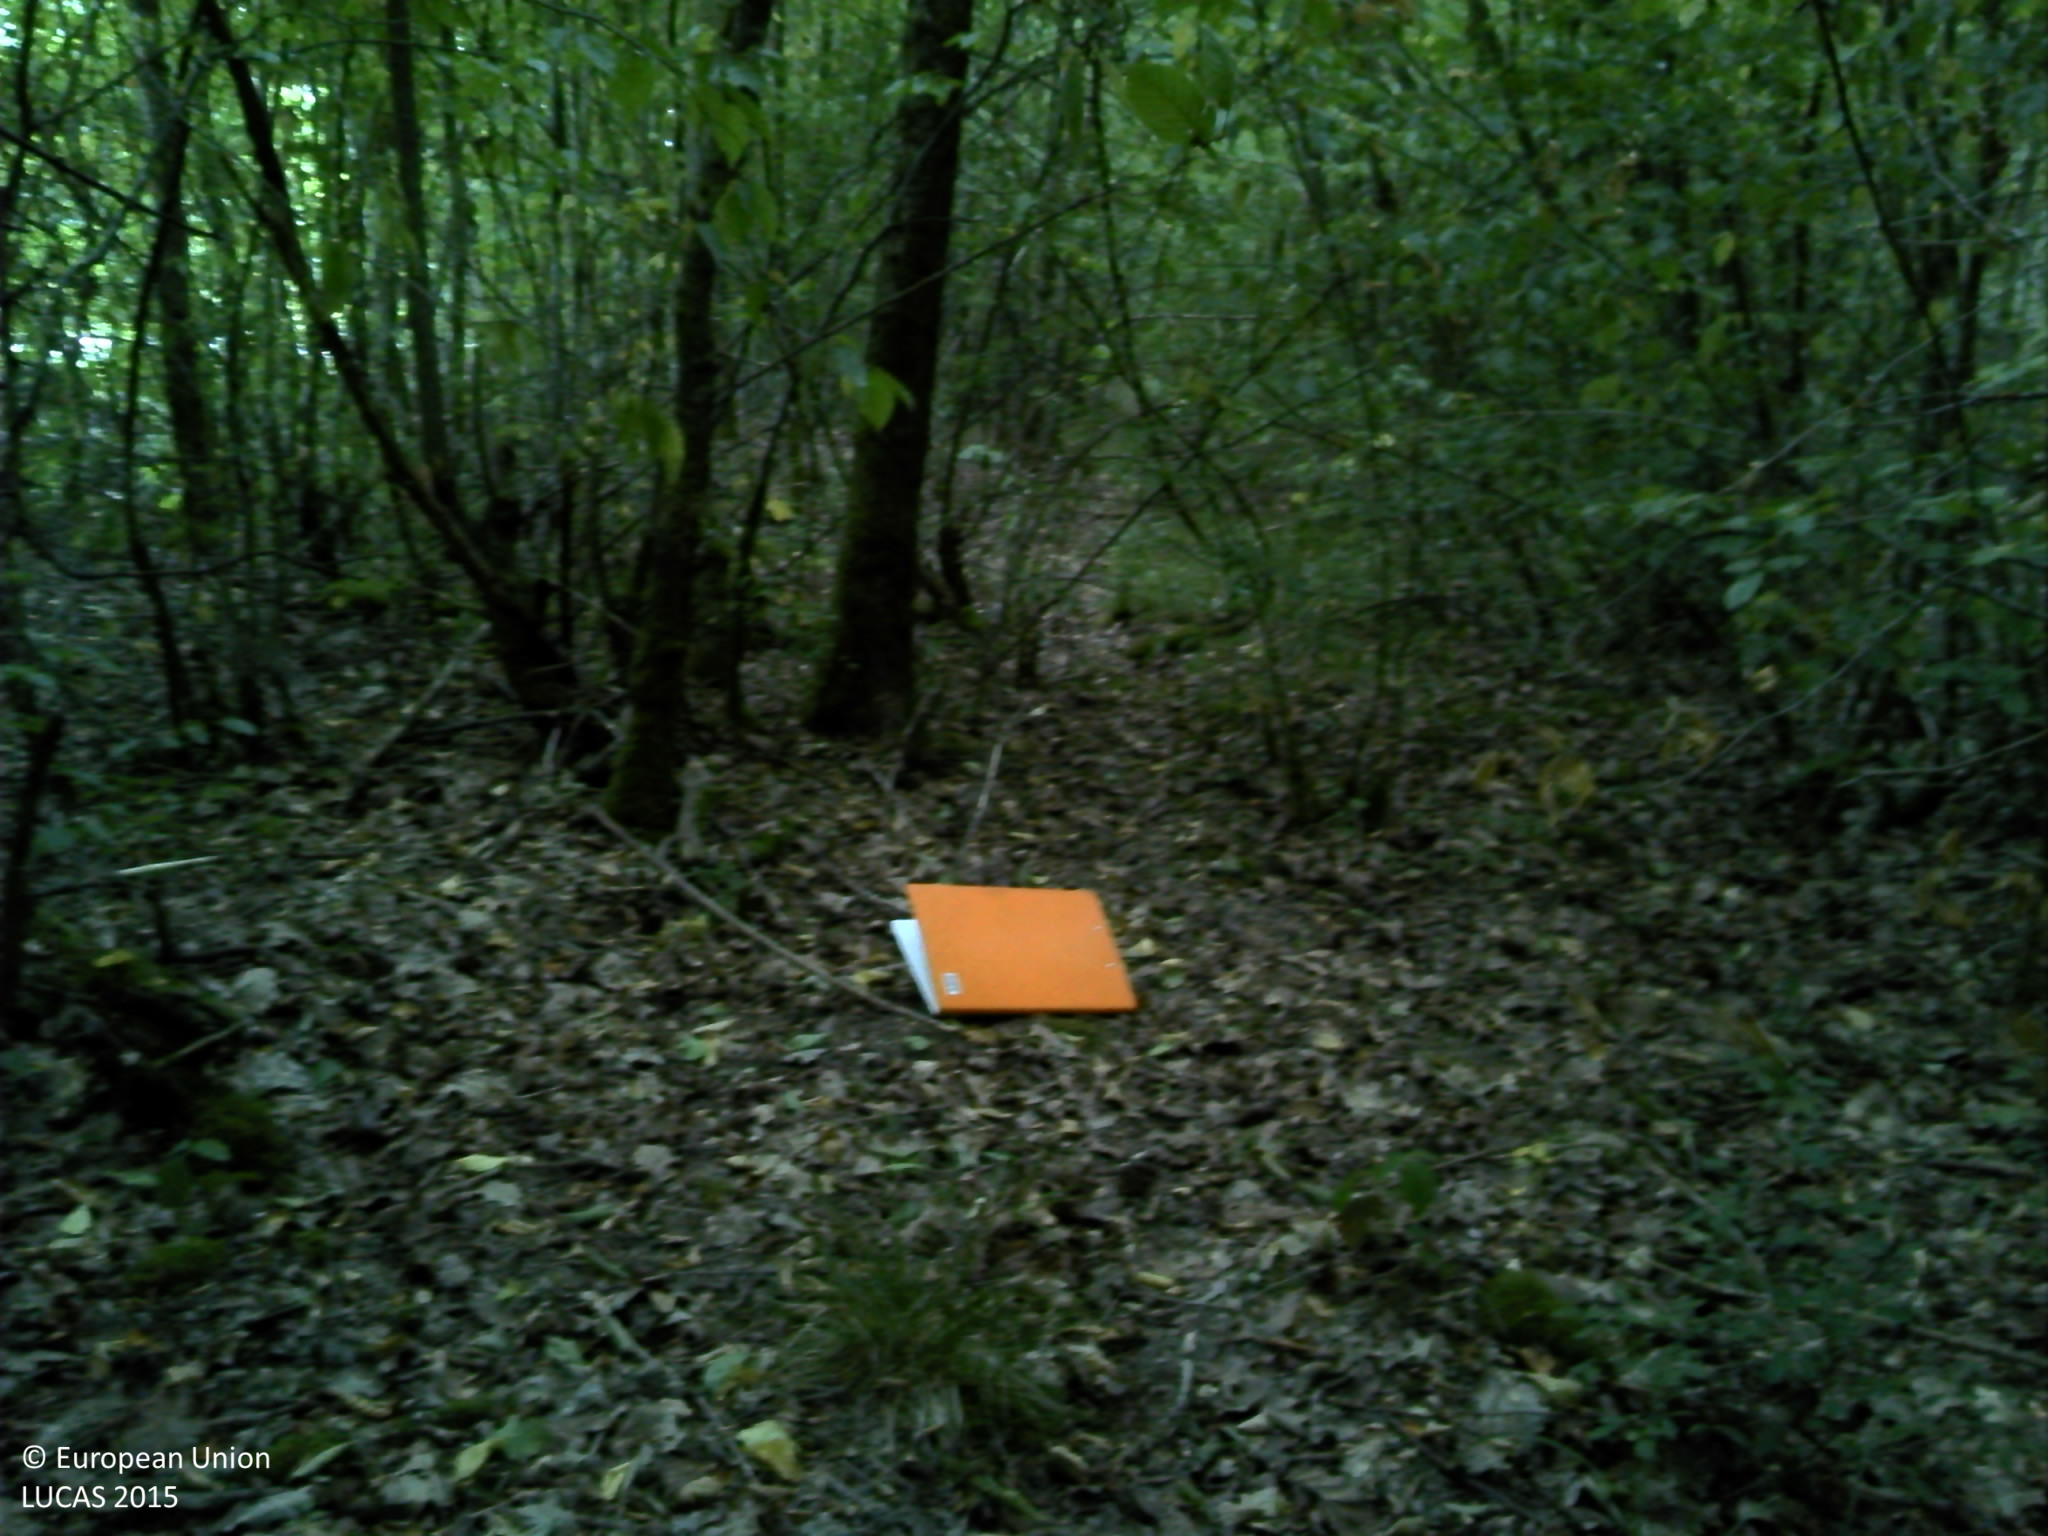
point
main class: Woodland
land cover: Broadleaved woodland
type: beech forest
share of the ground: > 75 %
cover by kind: broadleaved forest trees 100 %
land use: Forestry
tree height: > 5 m
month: July
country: FR
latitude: 48.1022
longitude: 6.1464
